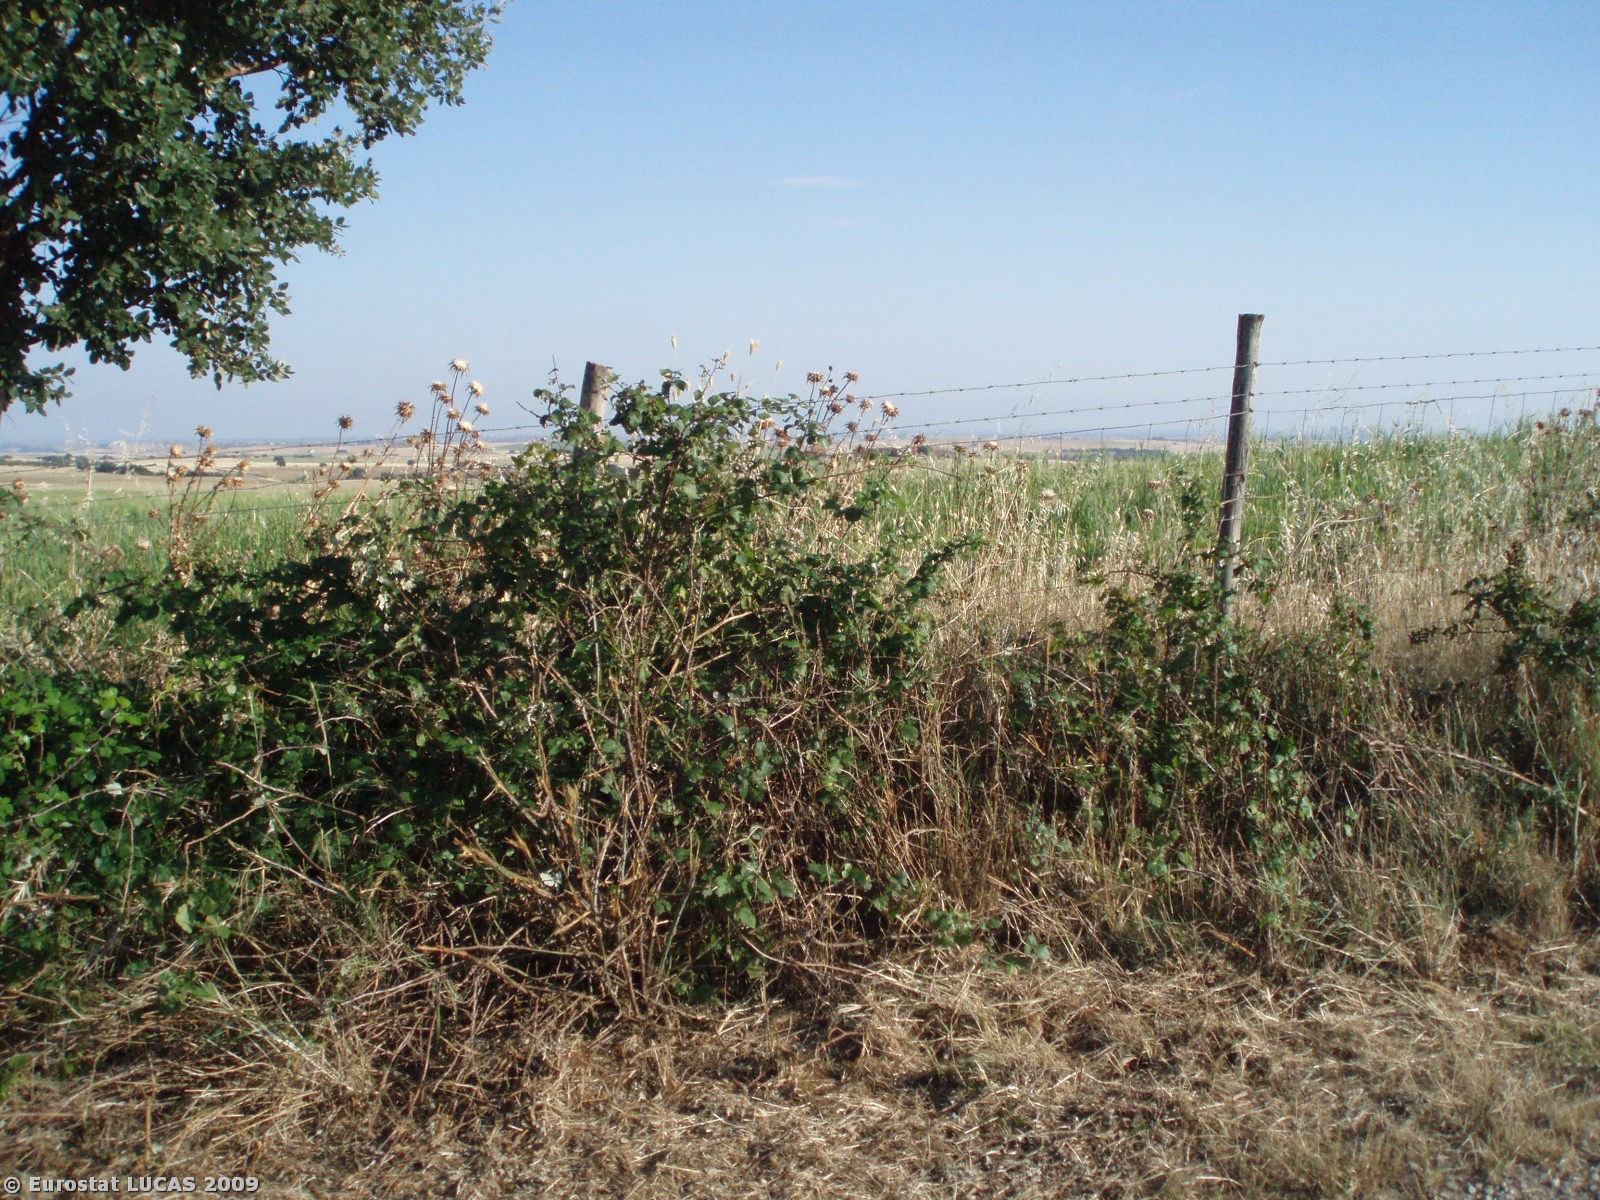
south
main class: Woodland
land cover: Broadleaved woodland
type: thermophilous deciduous forest
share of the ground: > 75 %
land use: Forestry
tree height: > 5 m
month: June
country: IT
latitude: 42.4790
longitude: 11.5881
